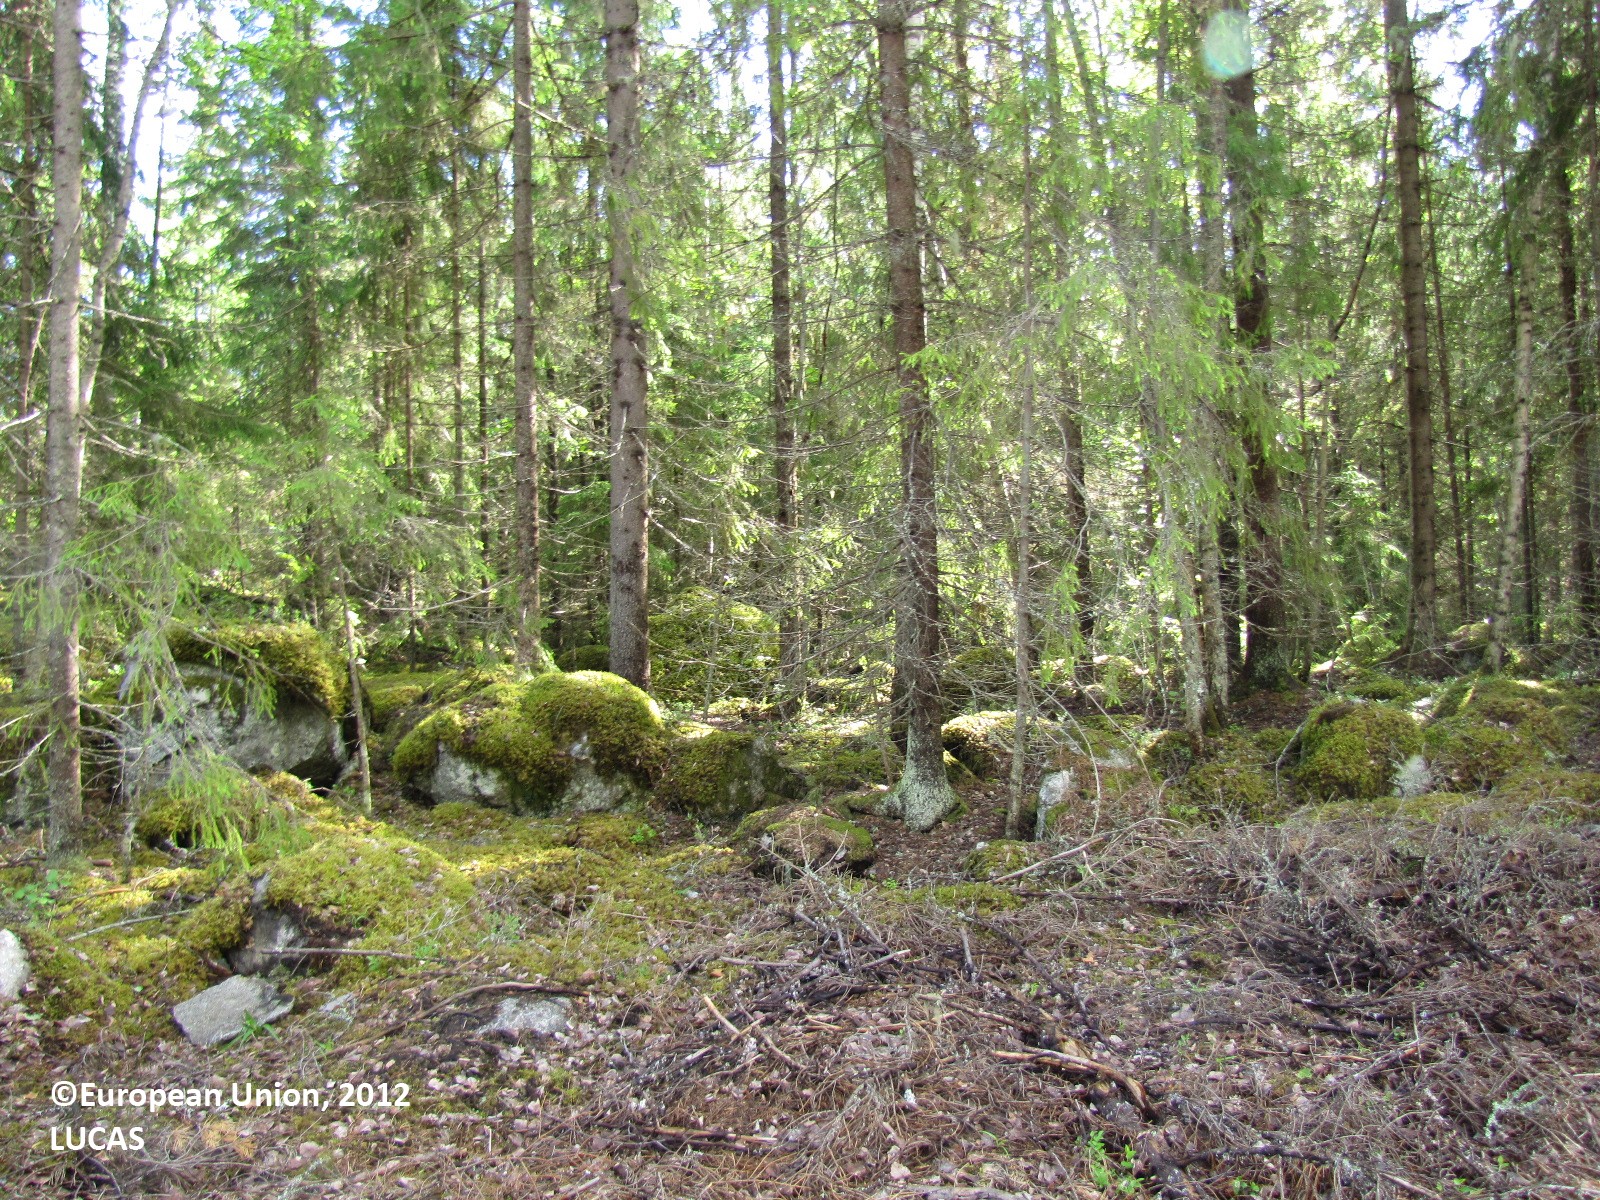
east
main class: Woodland
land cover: Pine dominated mixed woodland
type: boreal forest
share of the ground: 50 - 75 %
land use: Forestry
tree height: > 5 m
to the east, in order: Pine dominated mixed woodland; Spruce dominated coniferous woodland; Pine dominated coniferous woodland; Grassland with sparse tree/shrub cover
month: June
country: FI
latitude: 61.3936
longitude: 24.6502
